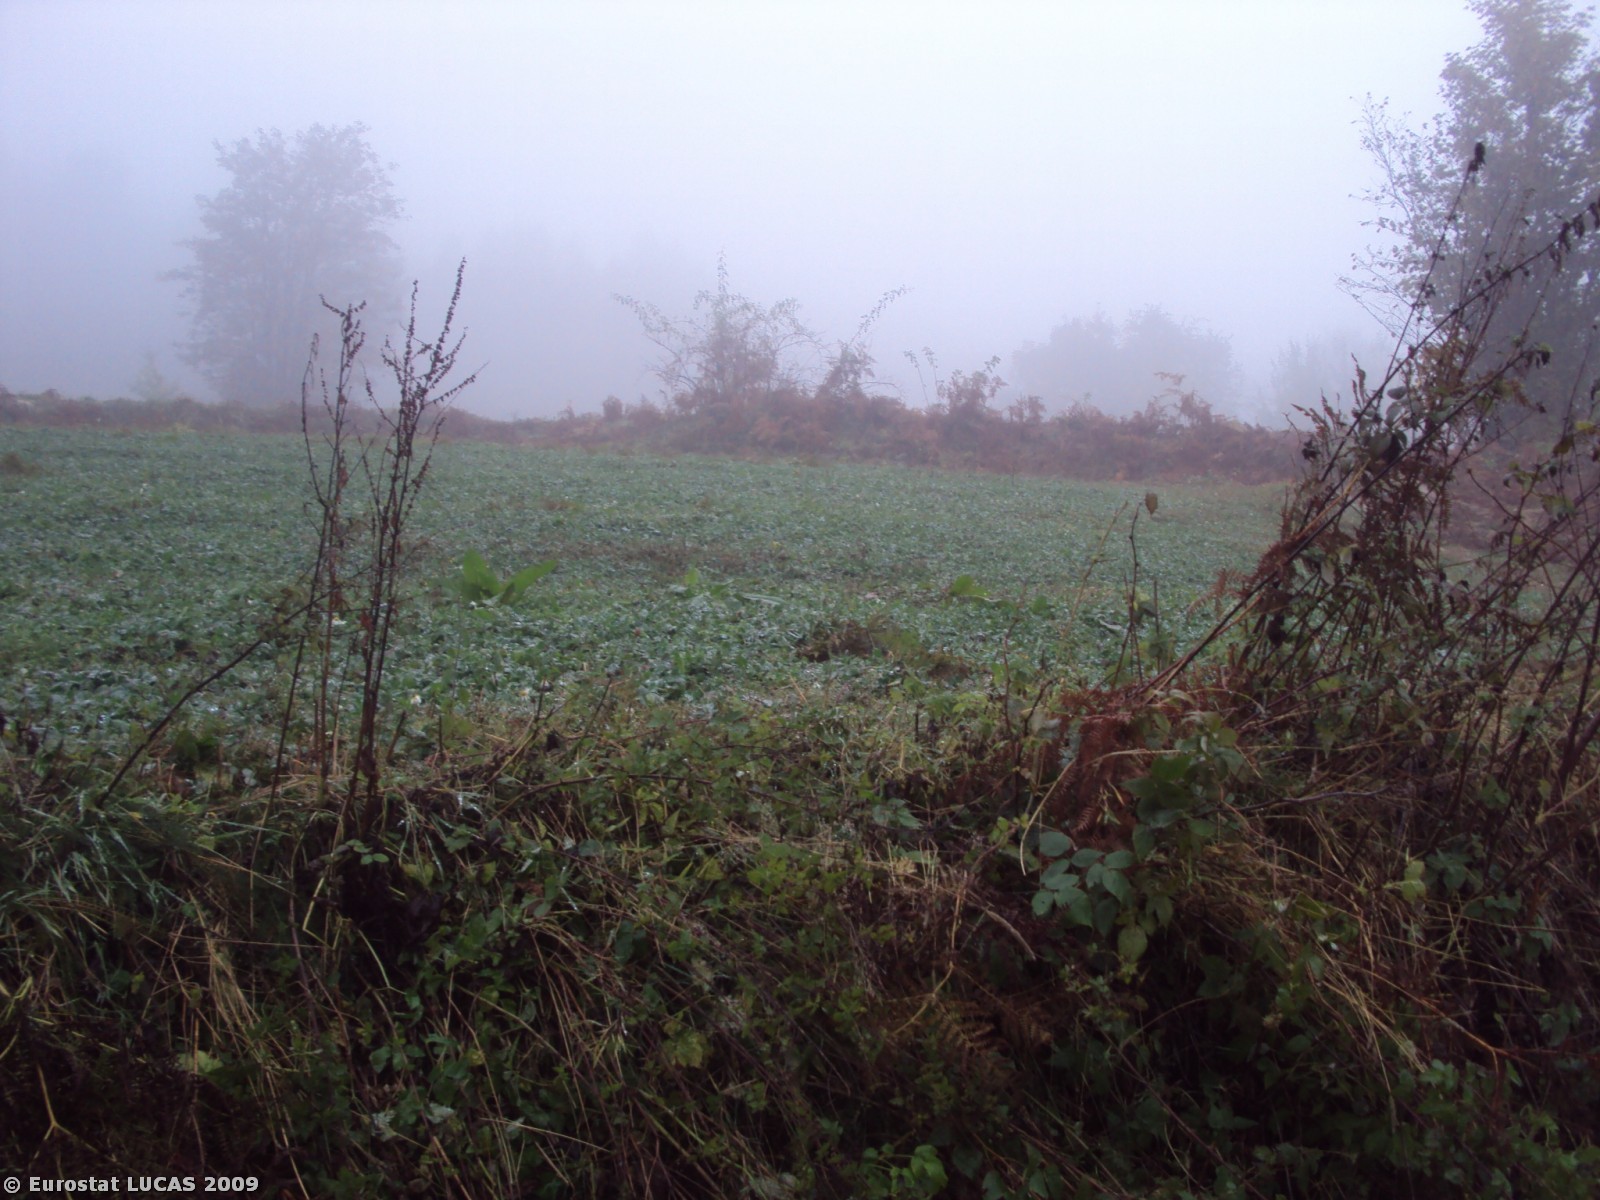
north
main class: Cropland
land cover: Common wheat
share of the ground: < 10 %
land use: Agriculture (excluding fallow land and kitchen gardens)
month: September
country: PL
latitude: 49.7678
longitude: 19.9306
